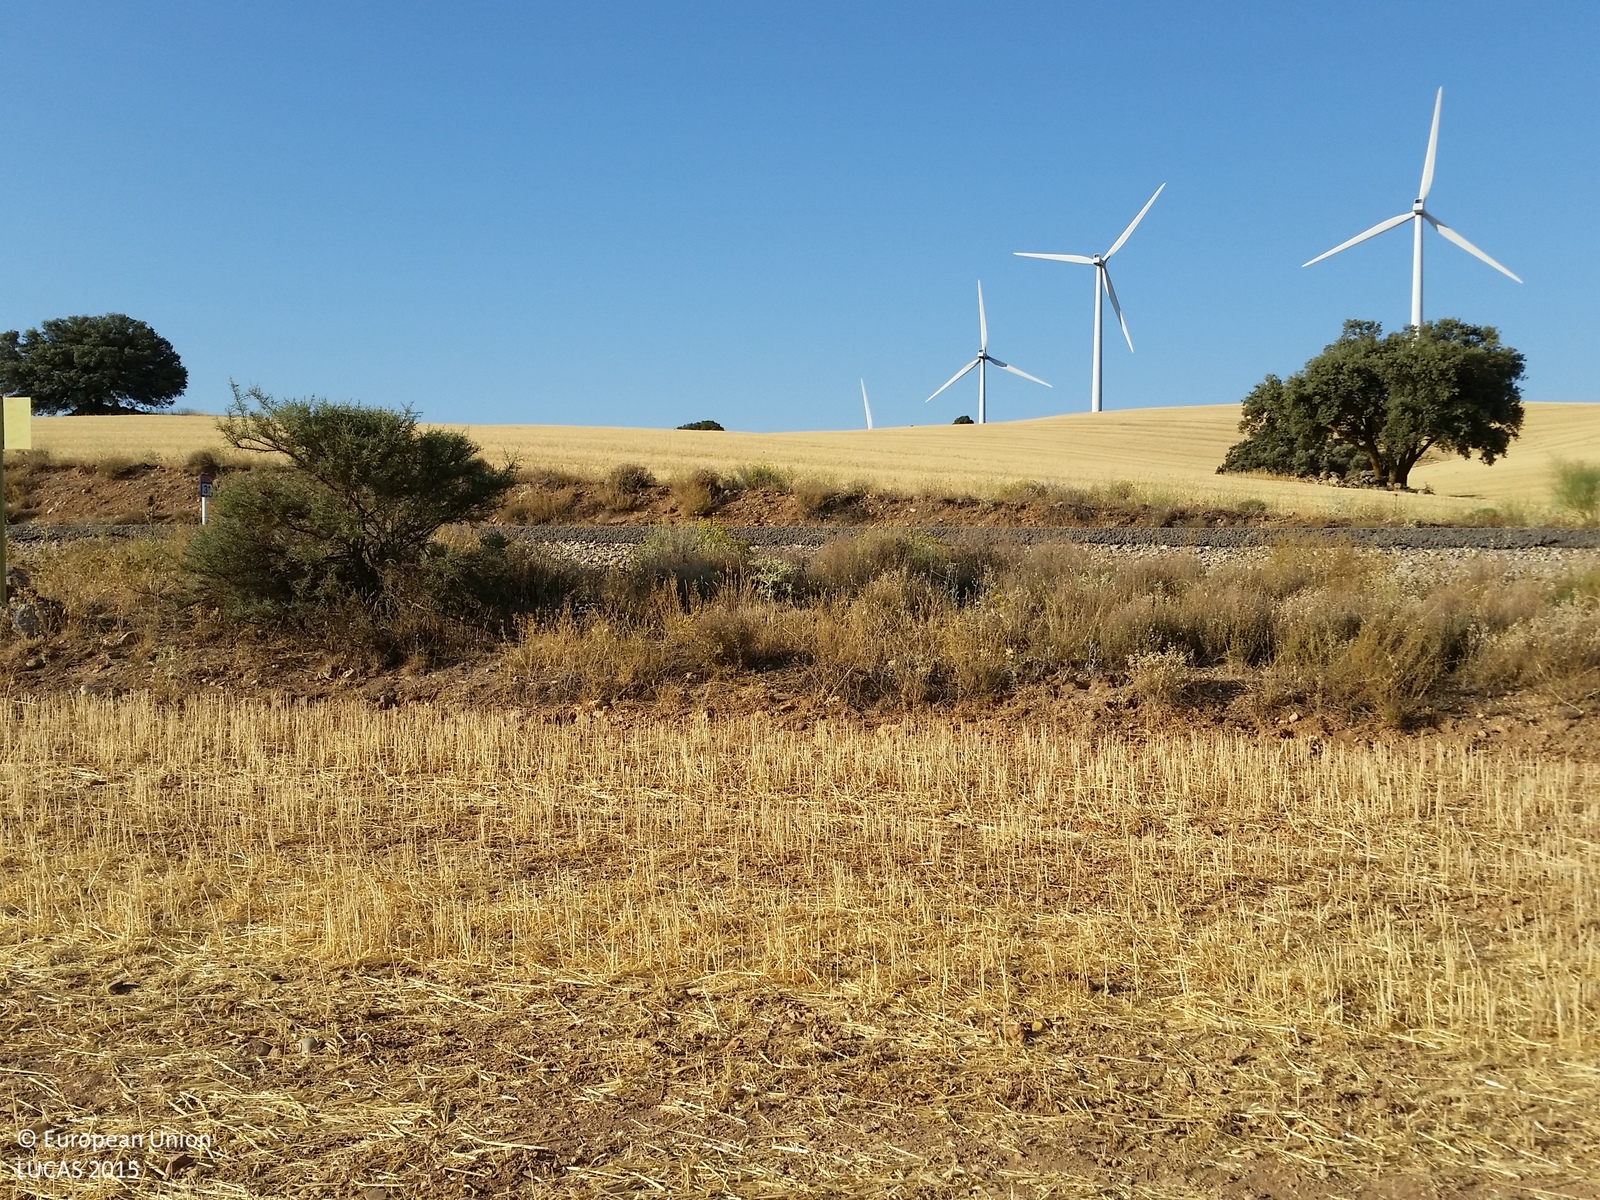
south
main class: Cropland
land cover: Common wheat
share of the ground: < 10 %
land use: Agriculture (excluding fallow land and kitchen gardens)
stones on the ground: 10 - 25 %
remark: Harvested field
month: July
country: ES
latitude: 39.0591
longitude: -2.6620
